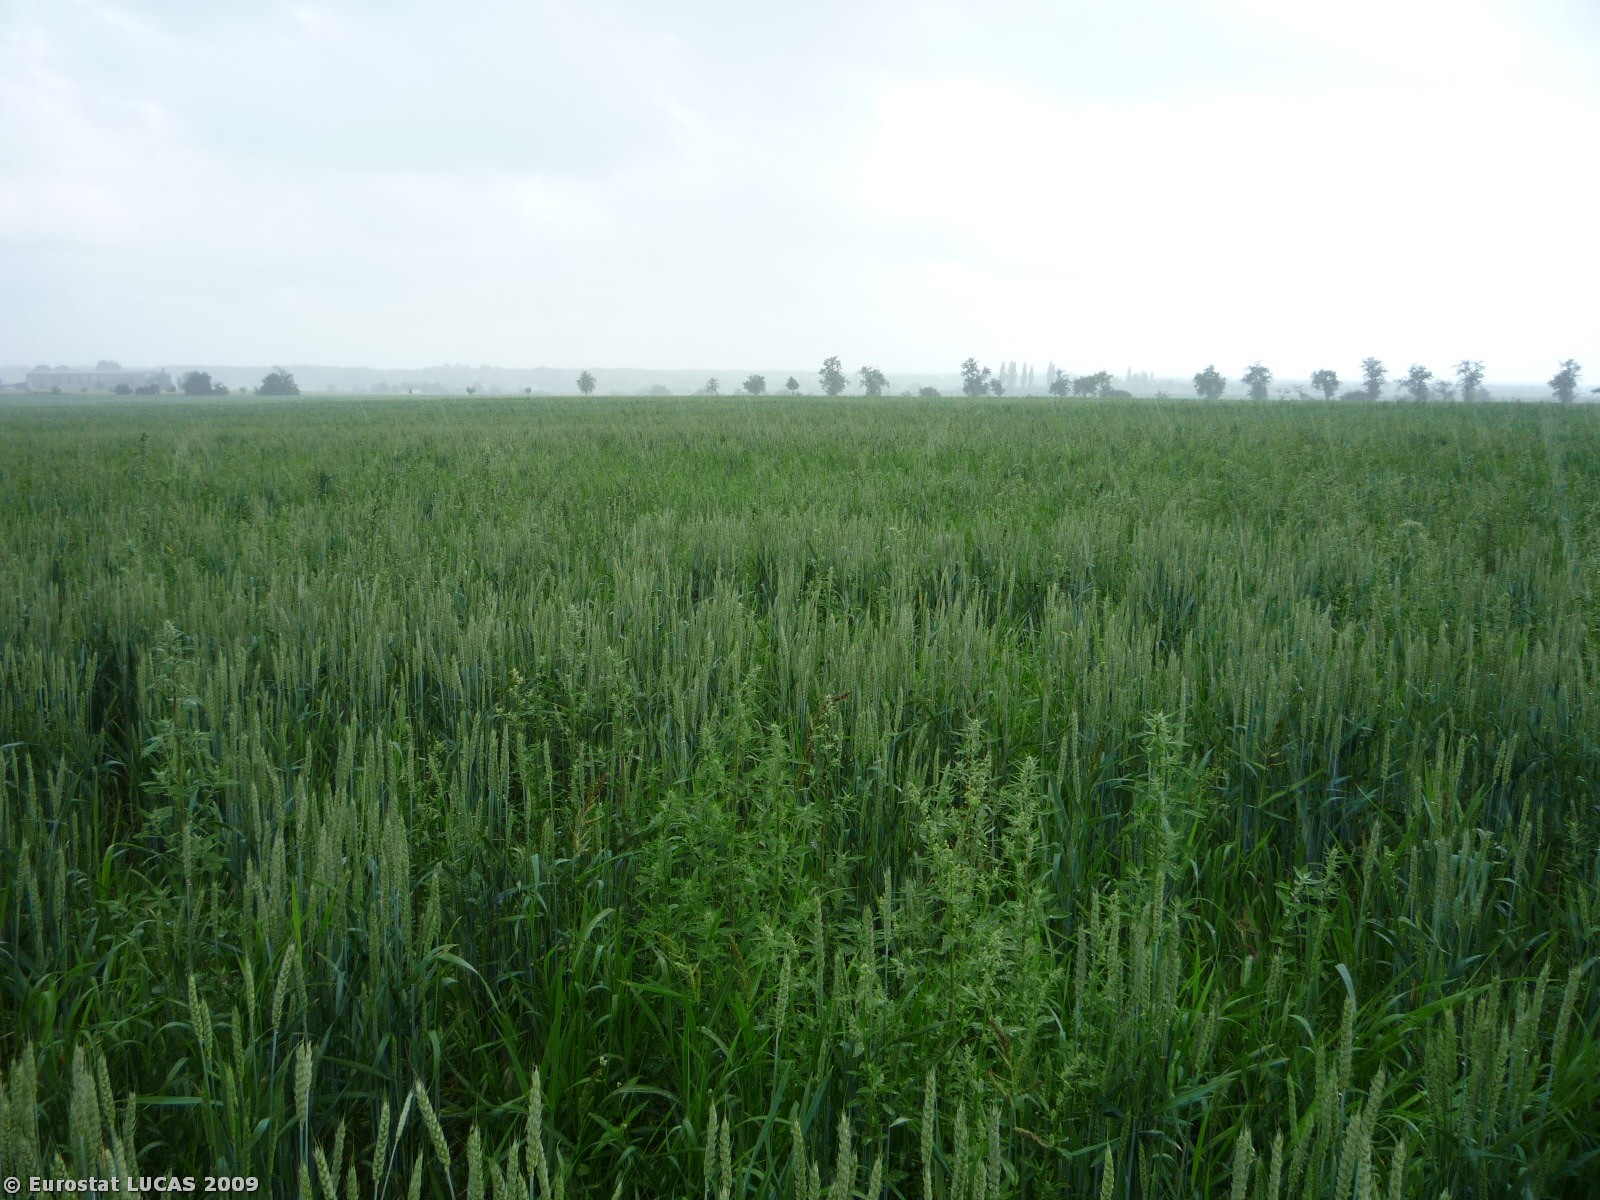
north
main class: Cropland
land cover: Common wheat
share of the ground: > 75 %
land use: Agriculture (excluding fallow land and kitchen gardens)
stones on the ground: < 10 %
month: June
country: CZ
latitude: 50.1415
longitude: 15.5031
